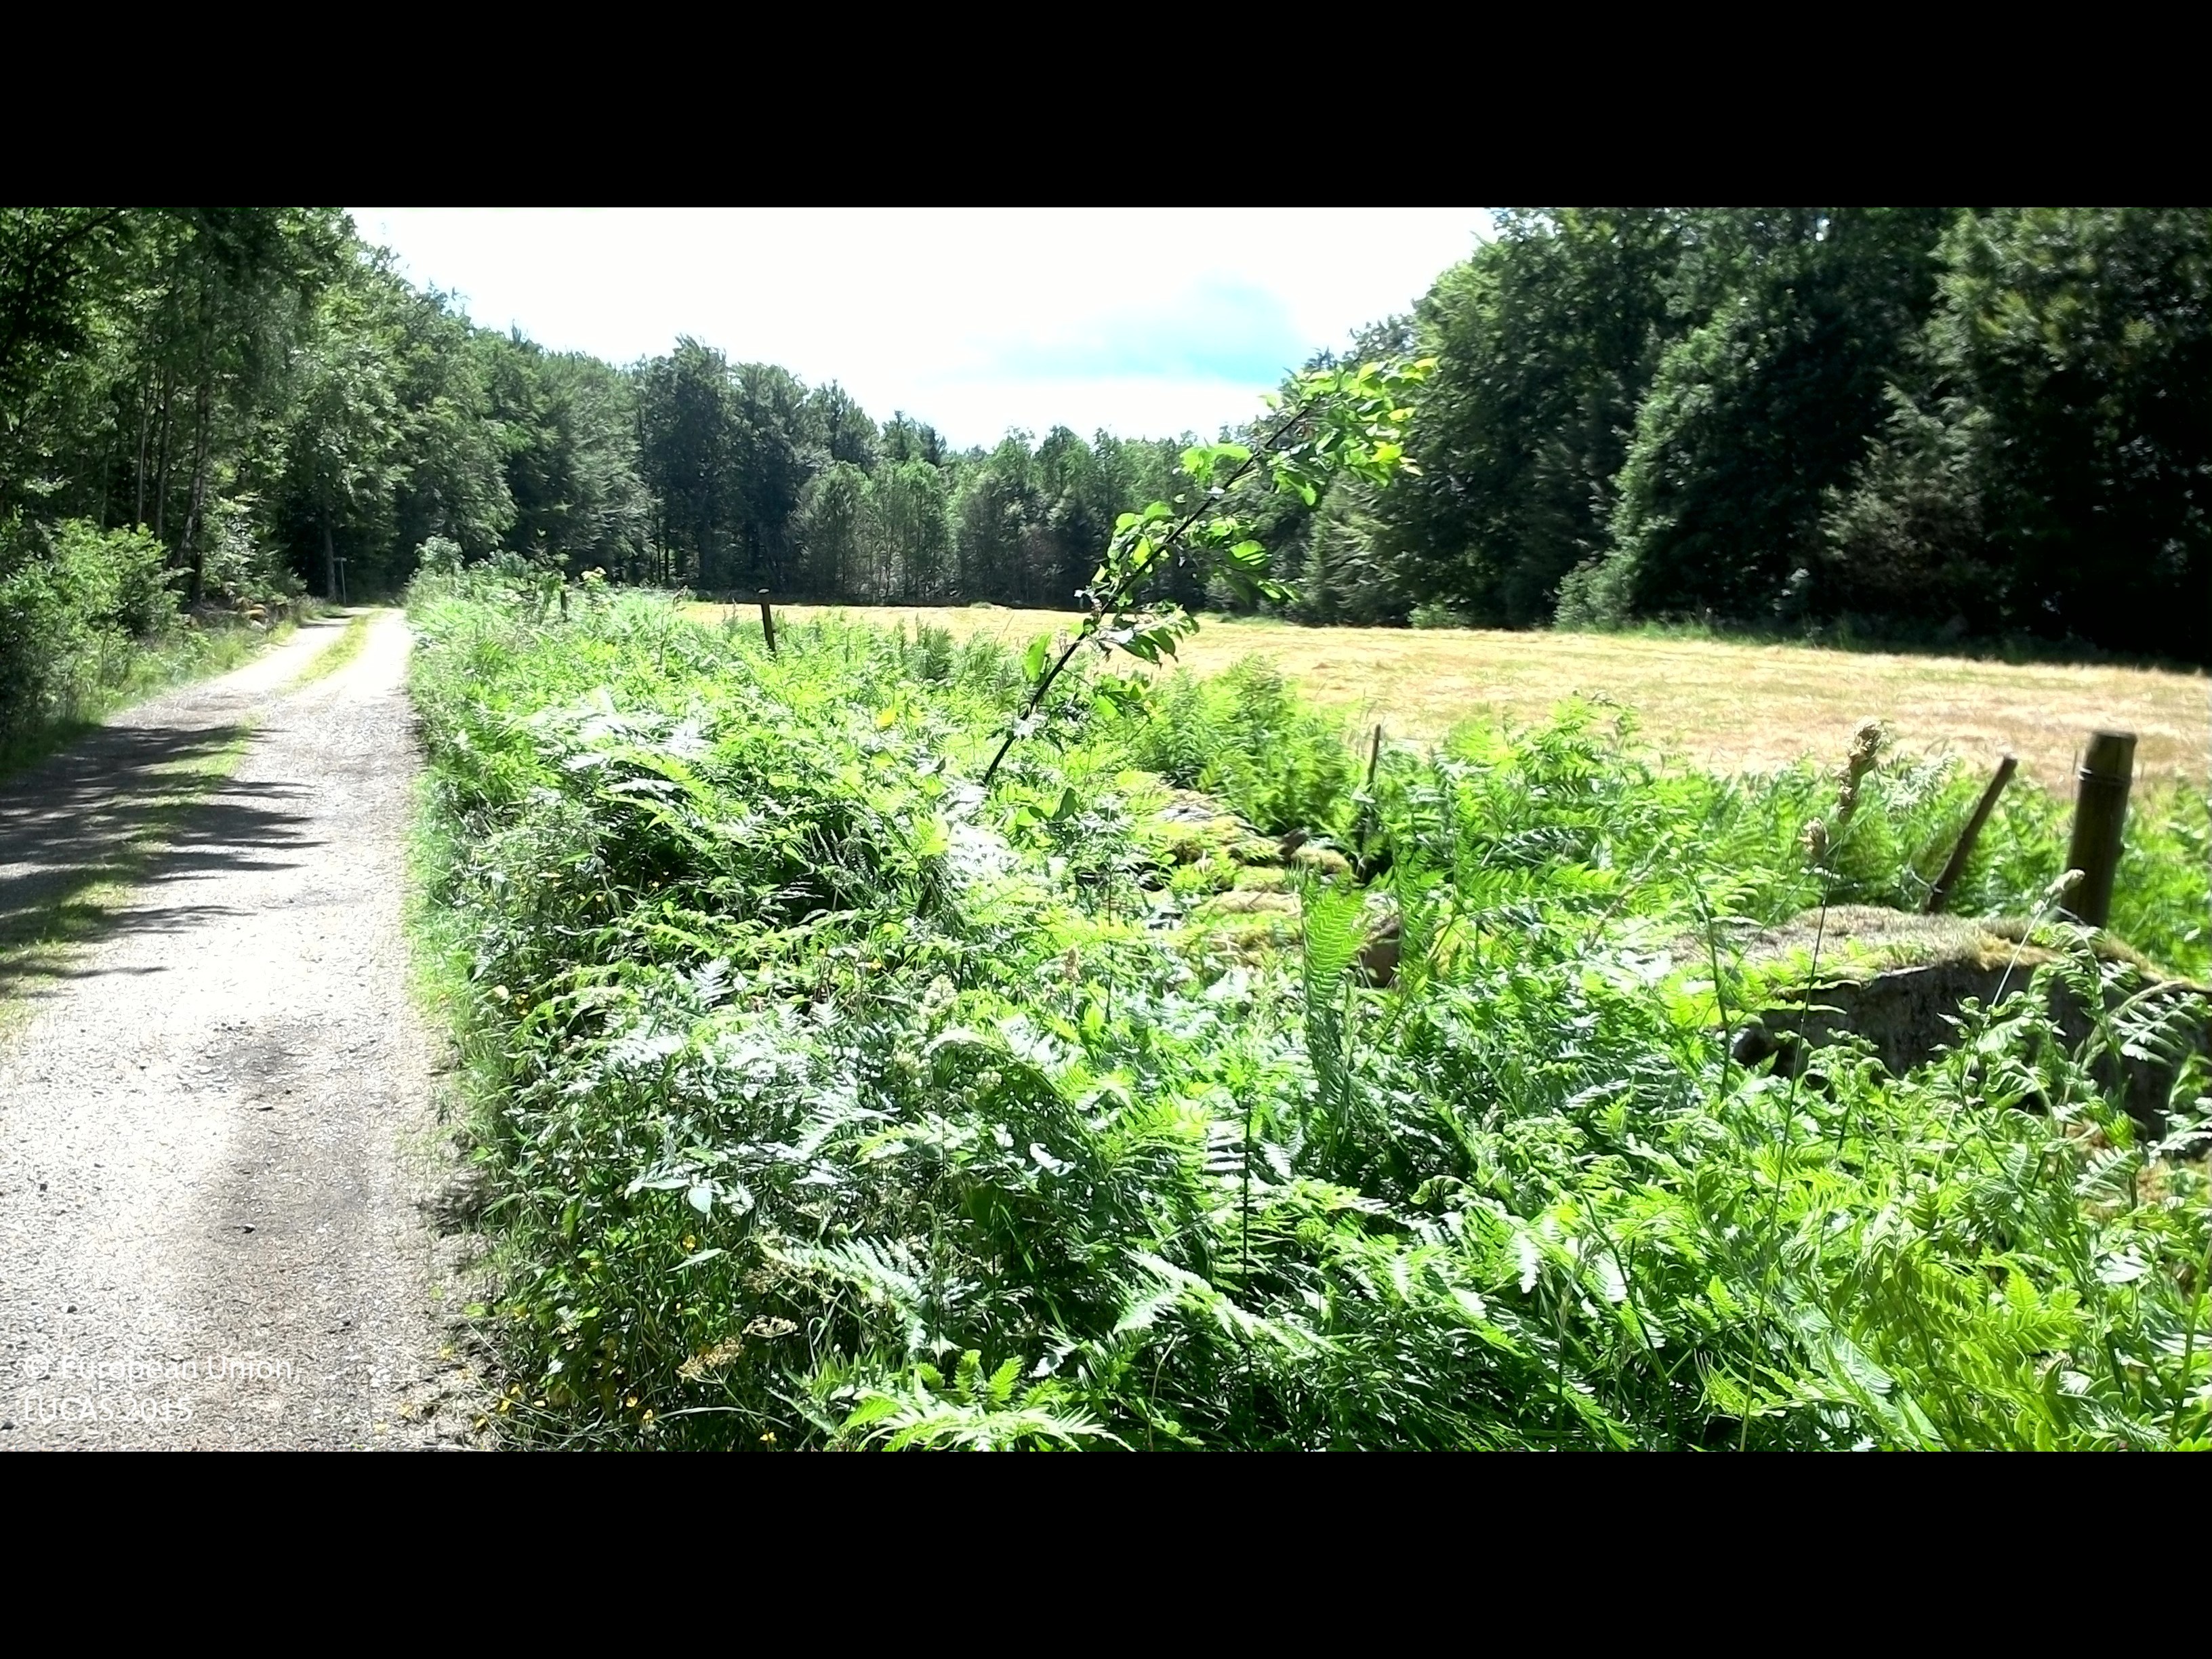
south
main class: Woodland
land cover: Broadleaved woodland
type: beech forest
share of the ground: > 75 %
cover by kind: broadleaved forest trees 75 %, herbaceous plants 20 %, shrubs 5 %
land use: Forestry
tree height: > 5 m
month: July
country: SE
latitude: 56.3709
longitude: 15.1958
